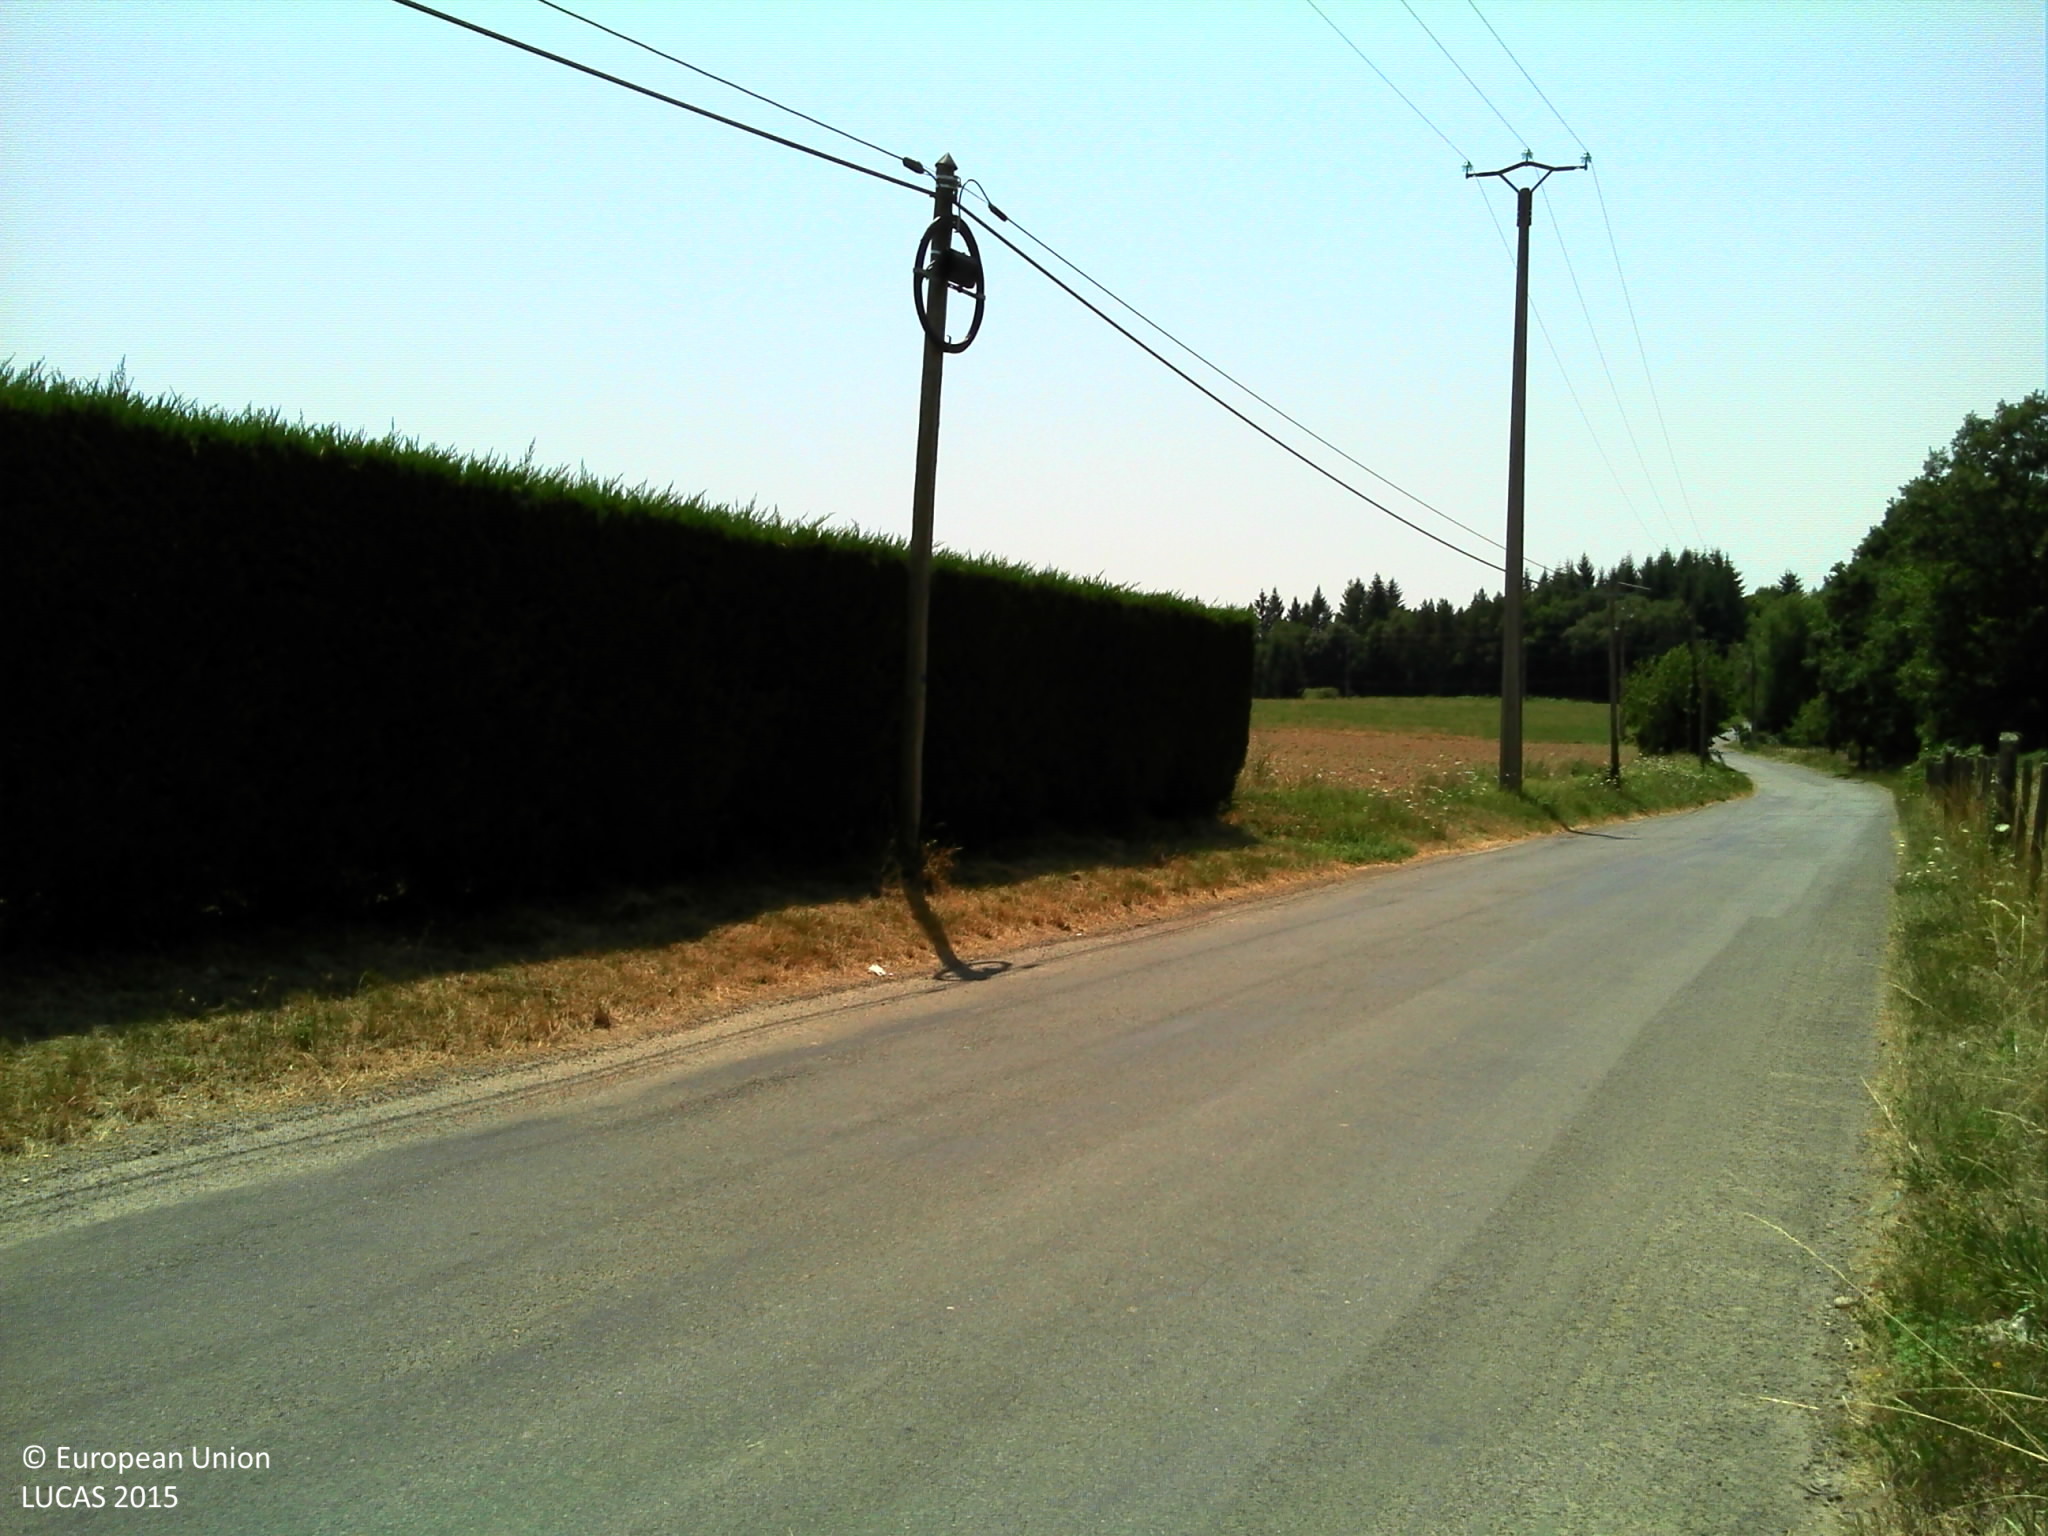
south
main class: Grassland
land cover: Grassland without tree/shrub cover
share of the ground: > 75 %
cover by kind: herbaceous plants 100 %
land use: Agriculture (excluding fallow land and kitchen gardens)
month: July
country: FR
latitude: 45.1179
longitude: 0.7747
